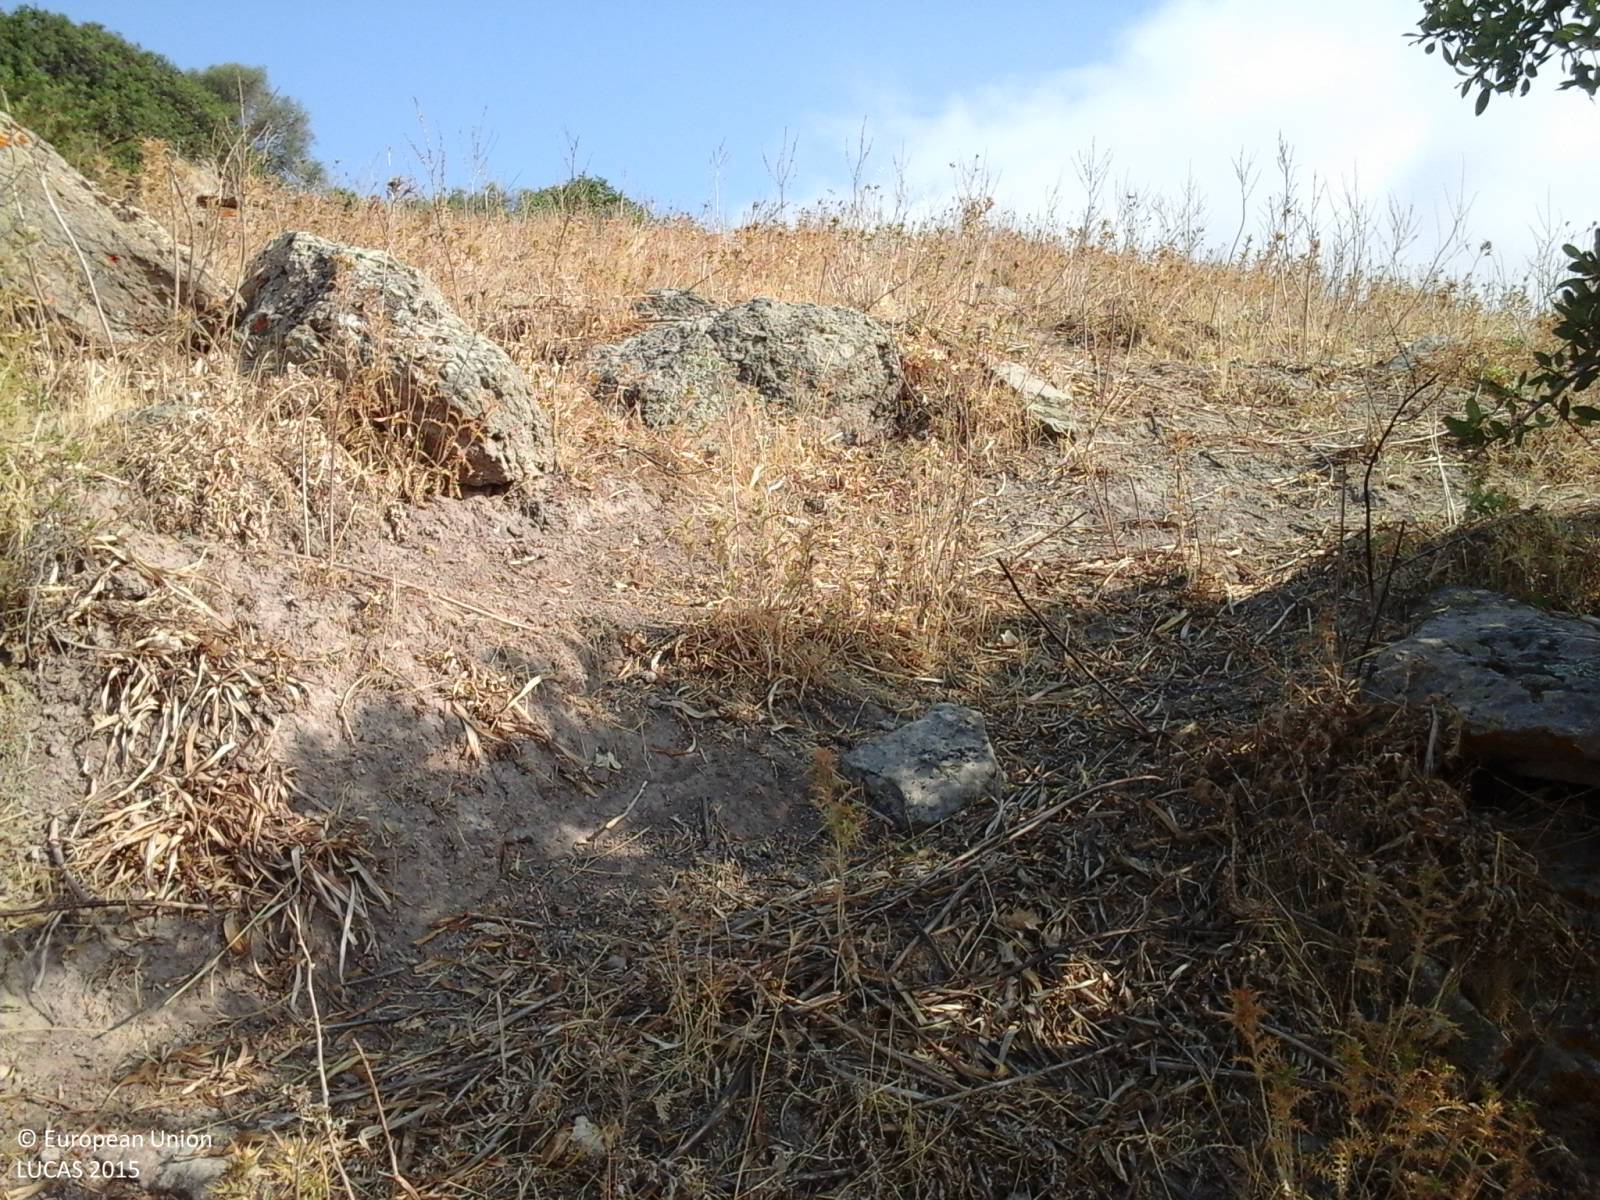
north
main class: Grassland
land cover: Grassland without tree/shrub cover
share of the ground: 10 - 25 %
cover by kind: herbaceous plants 100 %
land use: Agriculture (excluding fallow land and kitchen gardens)
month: July
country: IT
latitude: 40.6594
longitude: 8.9054
